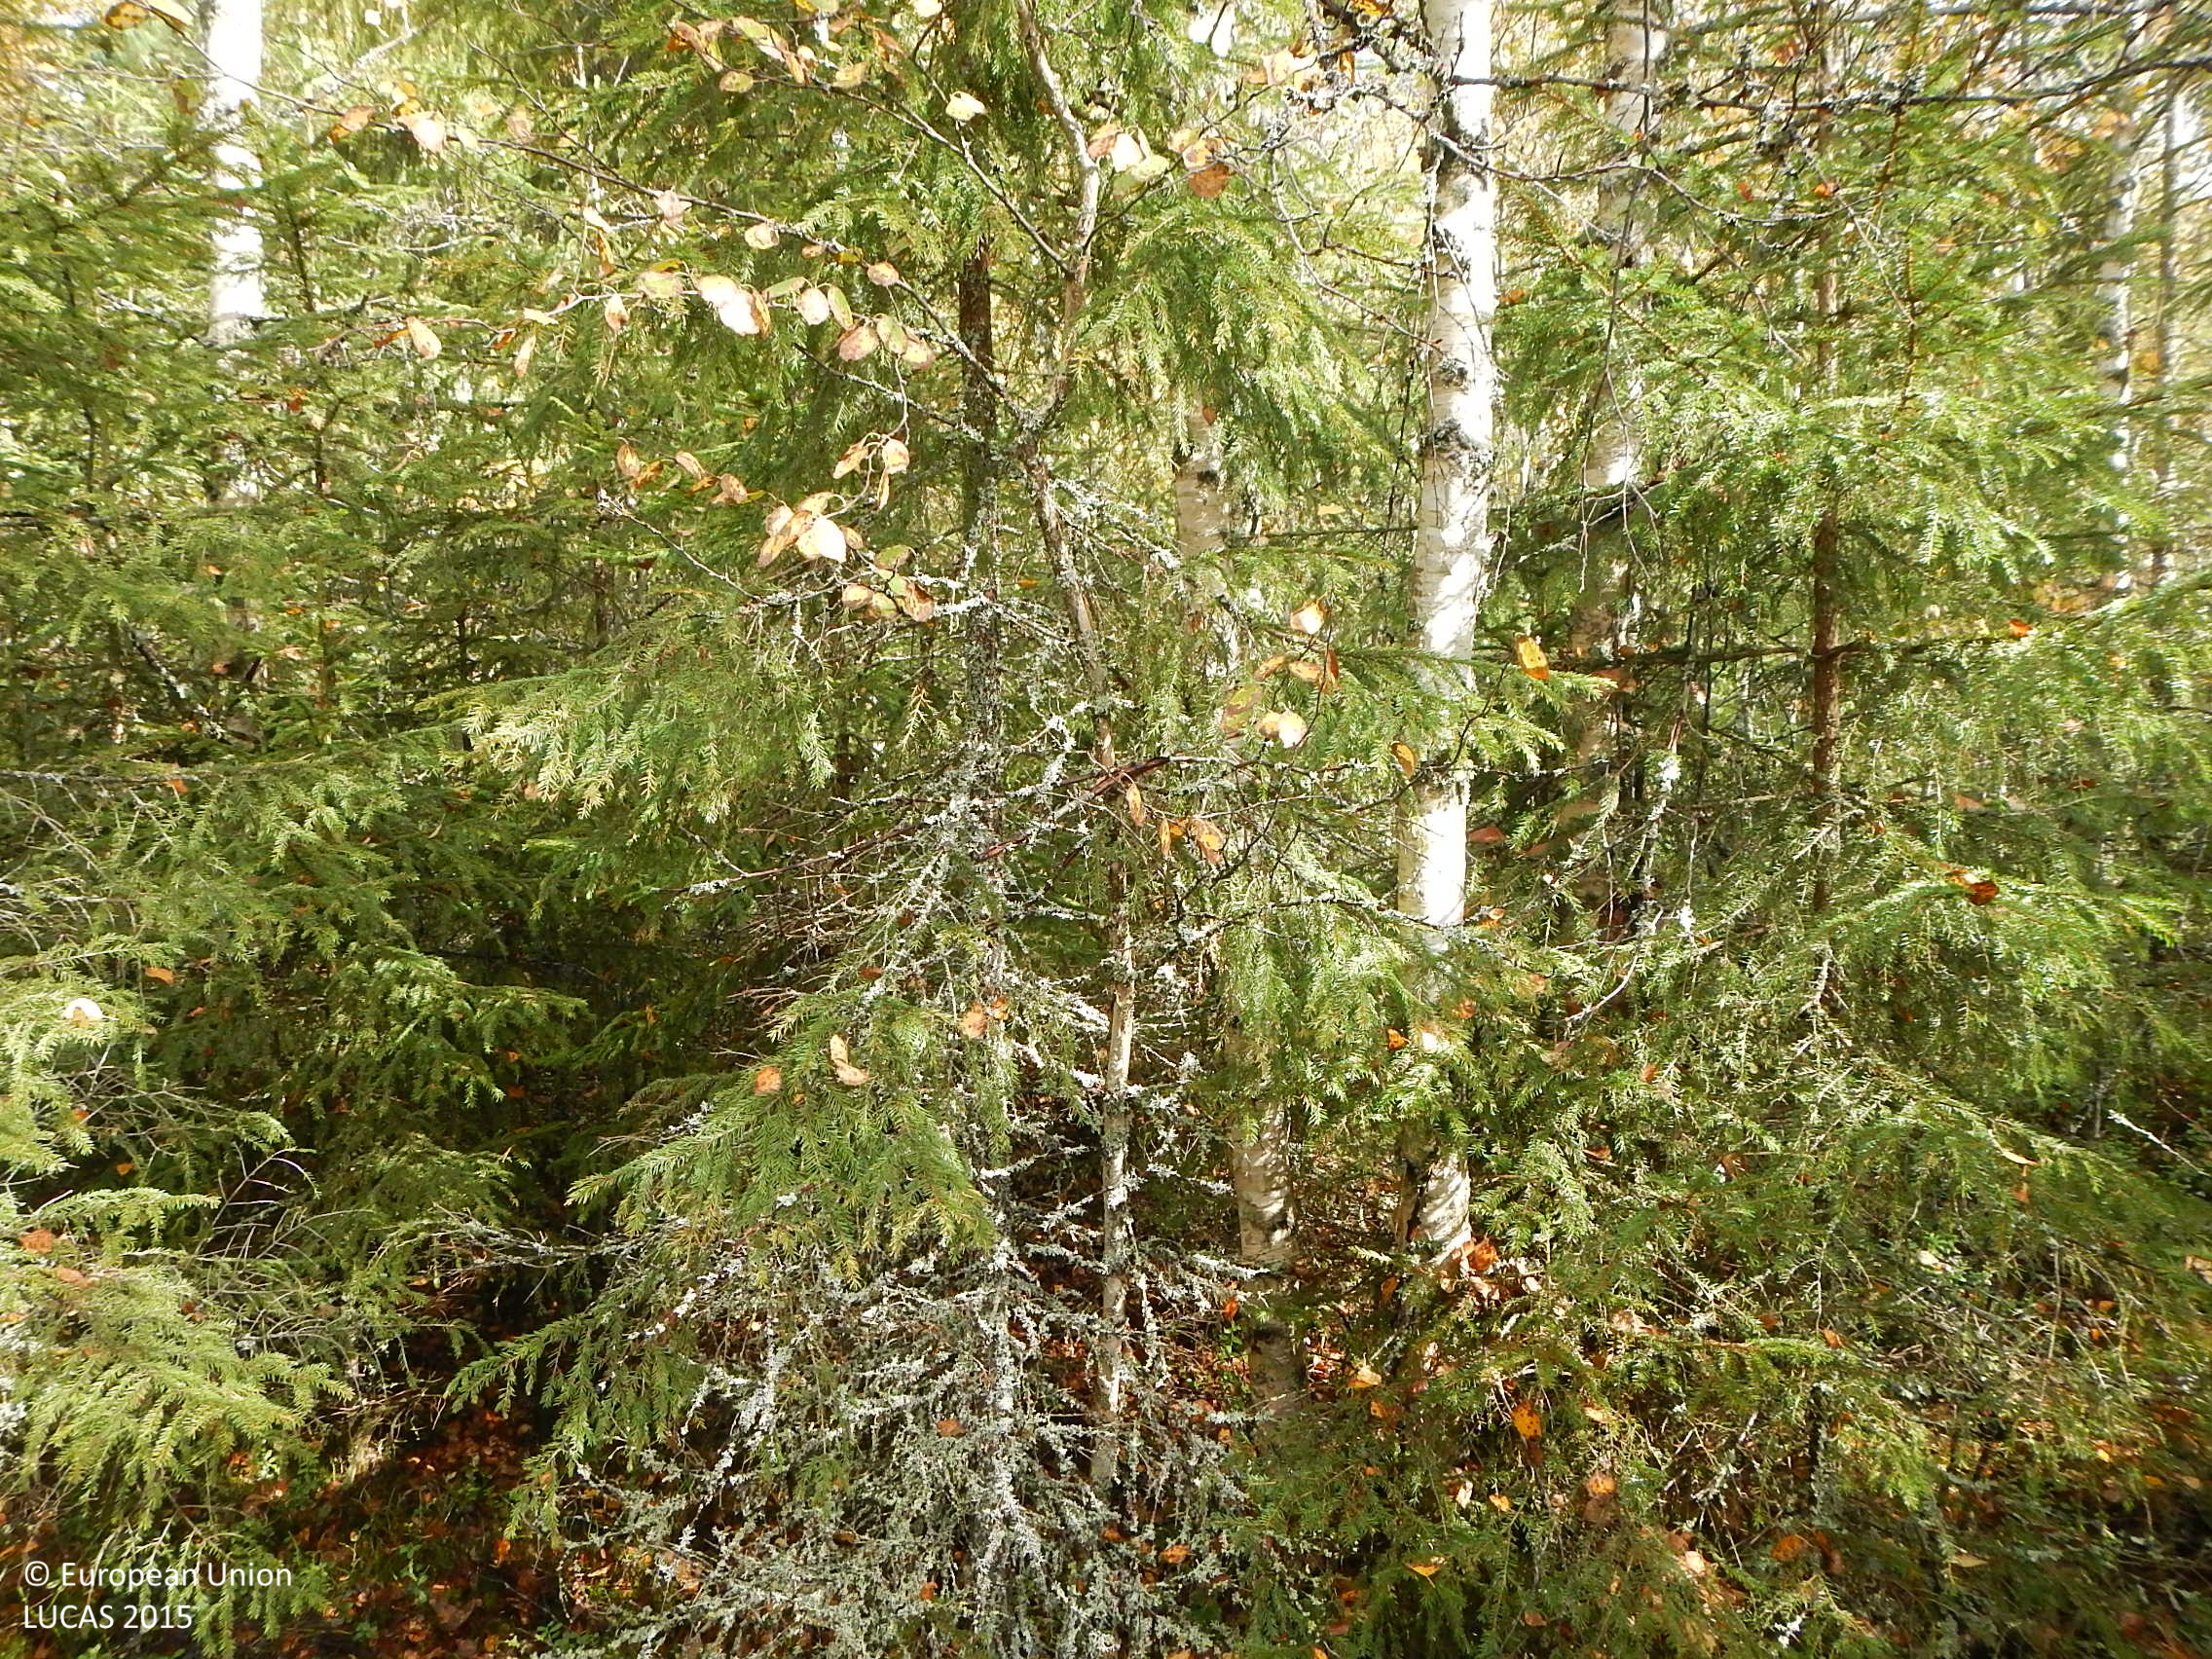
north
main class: Woodland
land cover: Other mixed woodland
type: boreal forest
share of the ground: 50 - 75 %
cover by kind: broadleaved forest trees 40 %, coniferous forest trees 30 %, shrubs 20 %, lichens and mosses 10 %
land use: Forestry
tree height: > 5 m
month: September
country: FI
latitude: 61.8571
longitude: 22.4320
